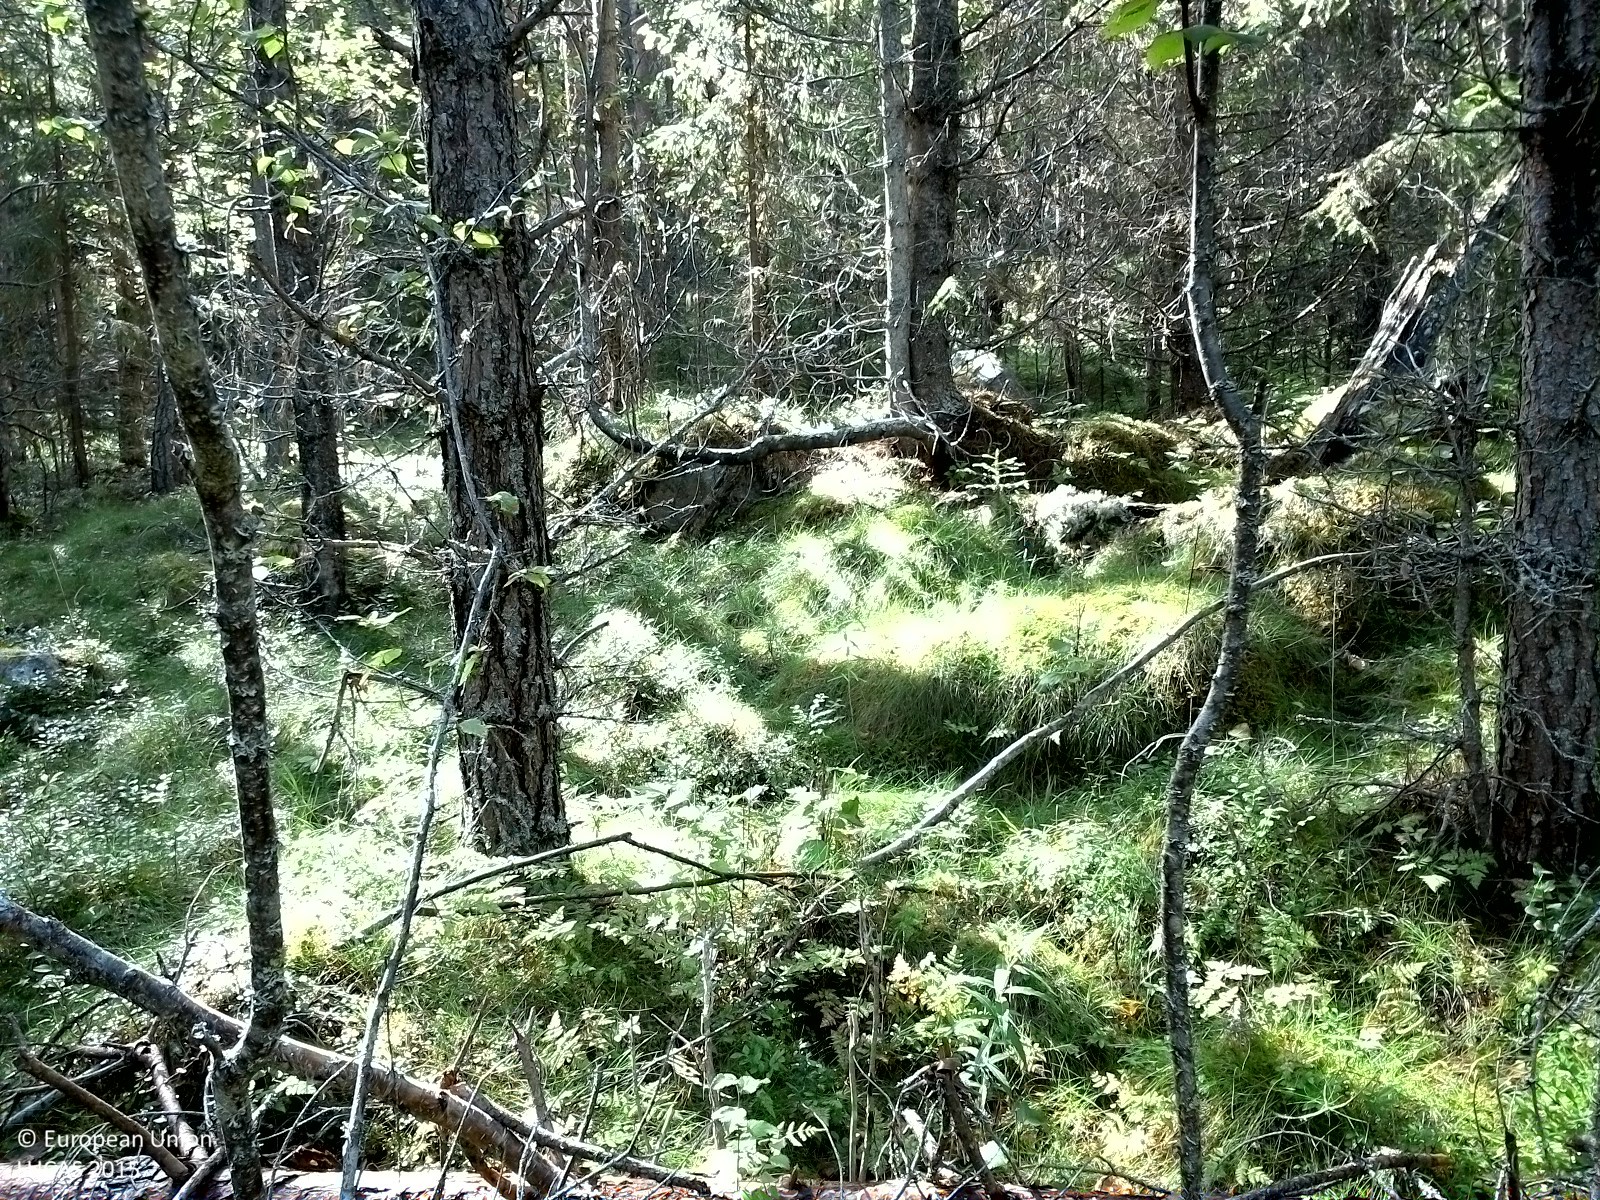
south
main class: Woodland
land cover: Pine dominated coniferous woodland
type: exotic forest
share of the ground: 50 - 75 %
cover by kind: coniferous forest trees 70 %, shrubs 10 %, herbaceous plants 10 %, lichens and mosses 10 %
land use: Forestry
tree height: > 5 m
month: September
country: SE
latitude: 62.5676
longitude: 16.3801
